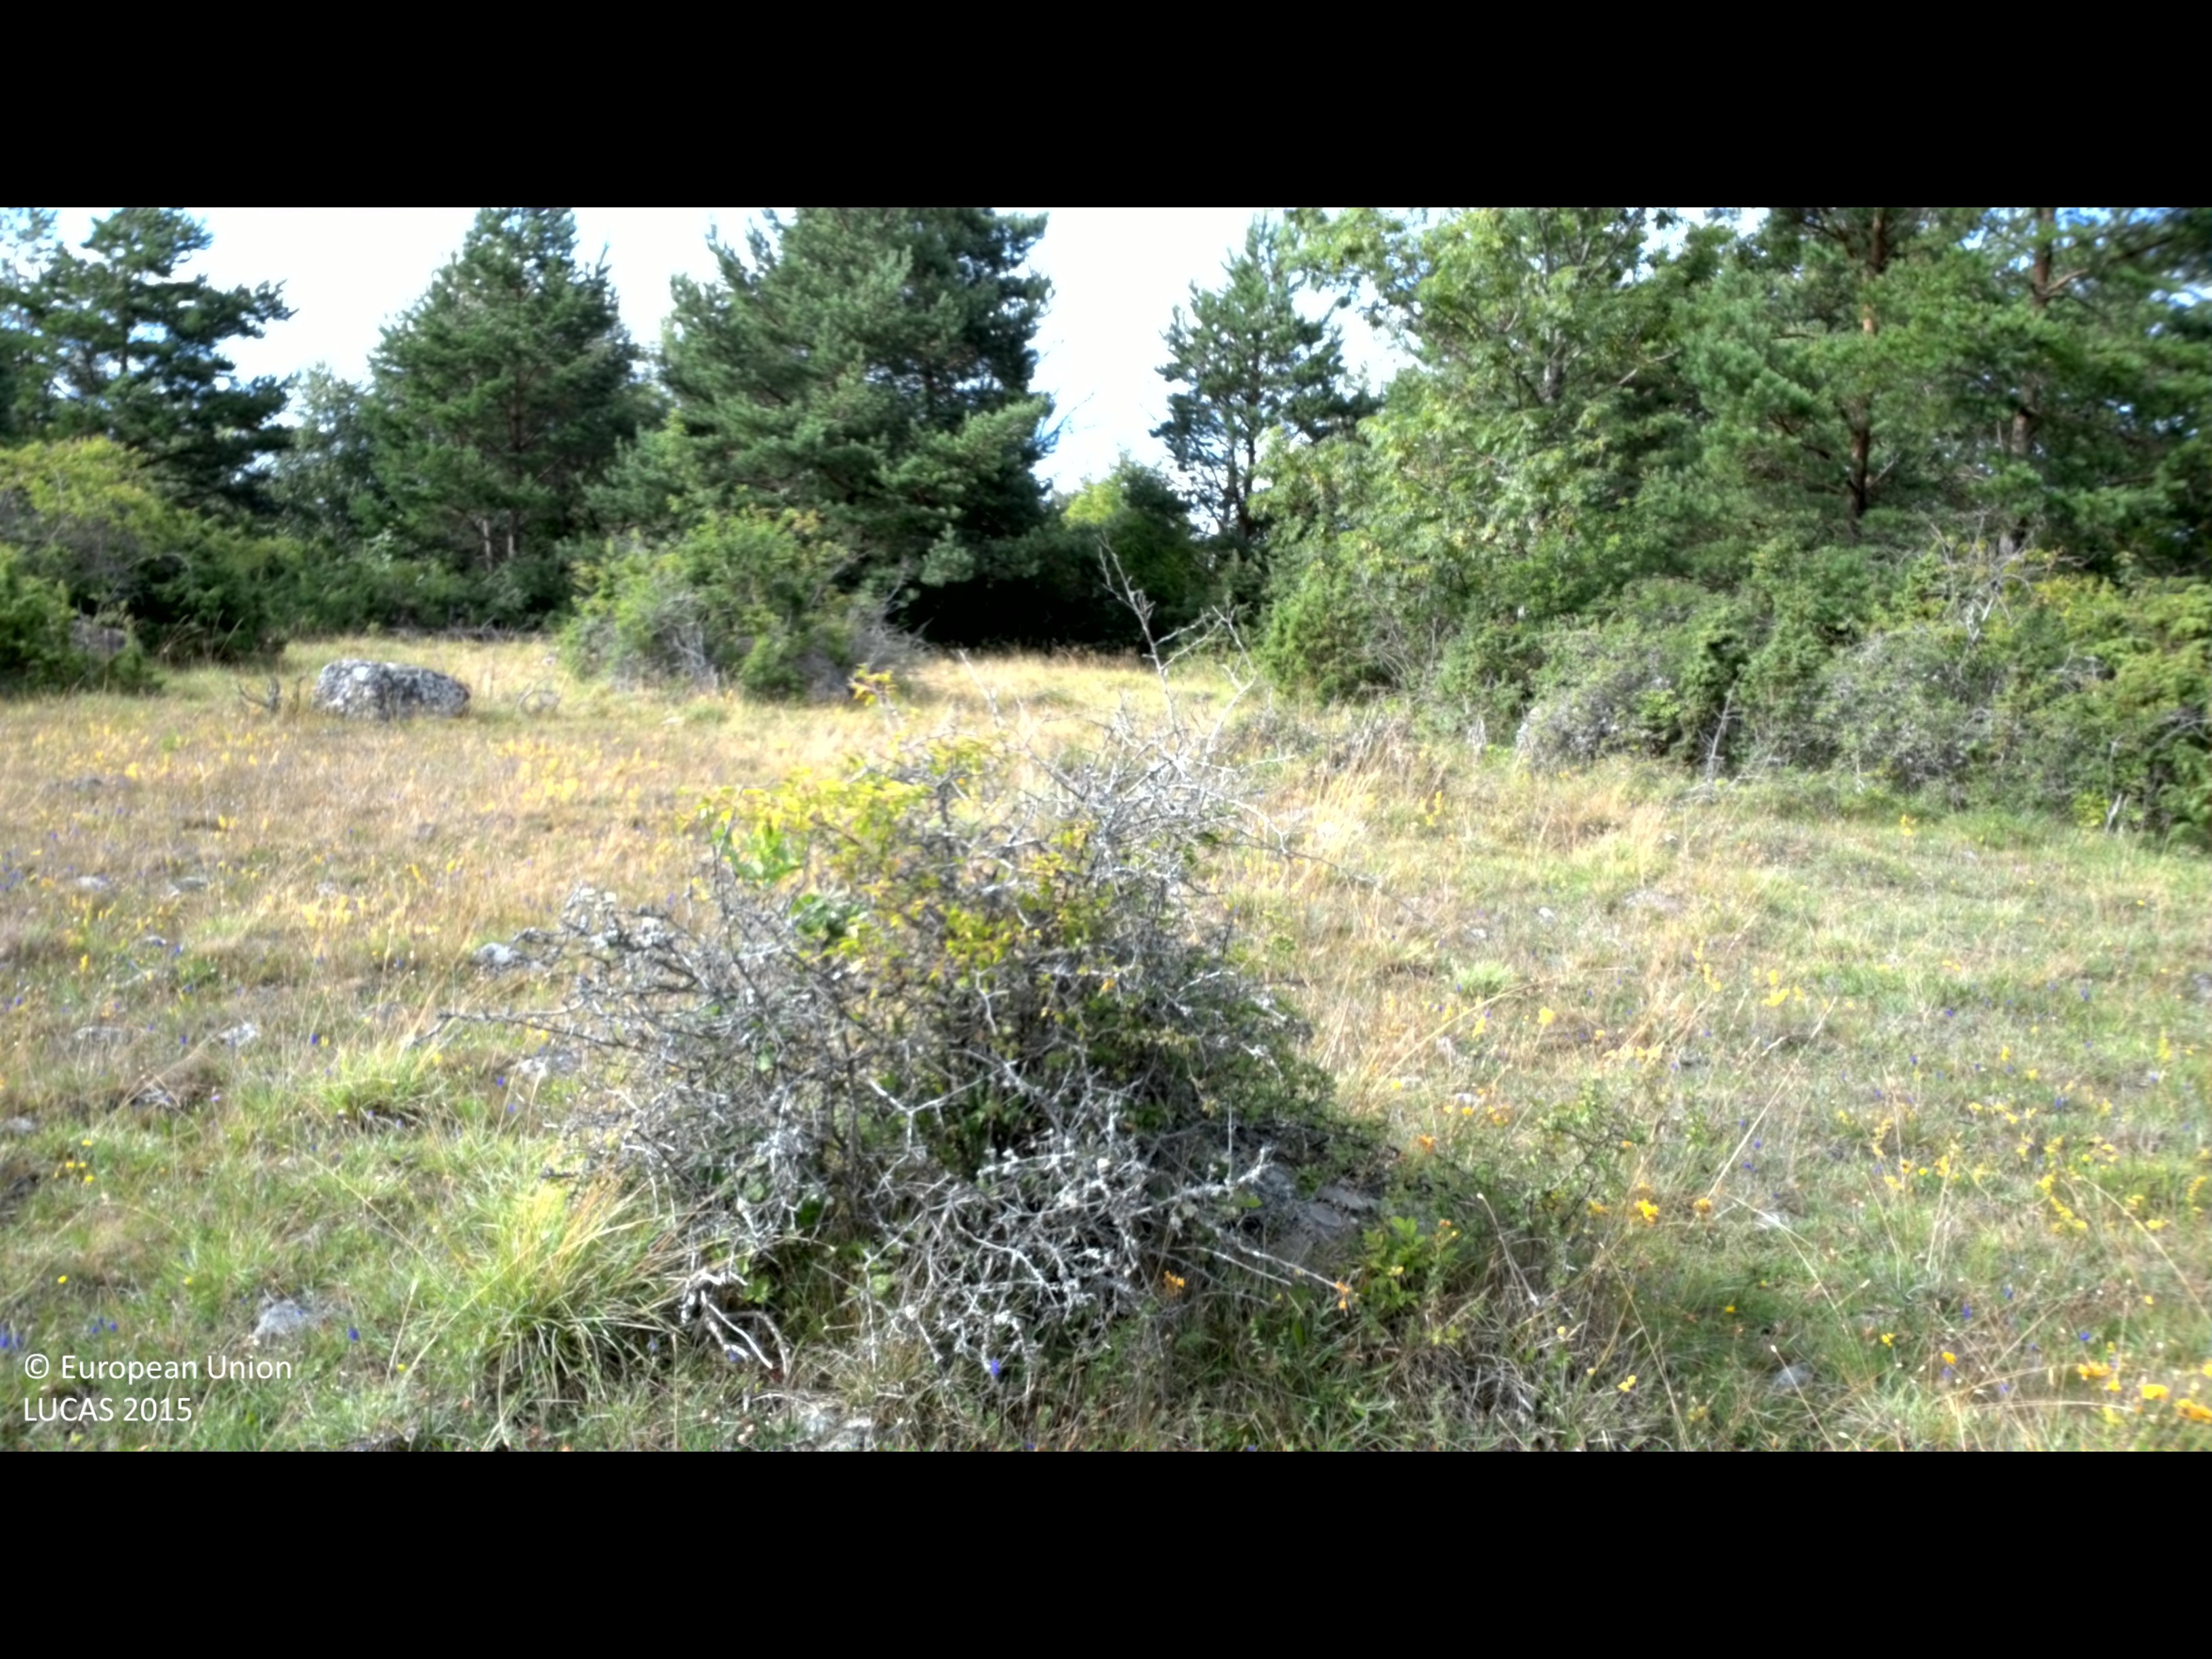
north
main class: Grassland
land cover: Grassland without tree/shrub cover
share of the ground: > 75 %
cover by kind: herbaceous plants 95 %, shrubs 5 %
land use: Agriculture (excluding fallow land and kitchen gardens)
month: July
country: SE
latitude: 57.1738
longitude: 16.9318
